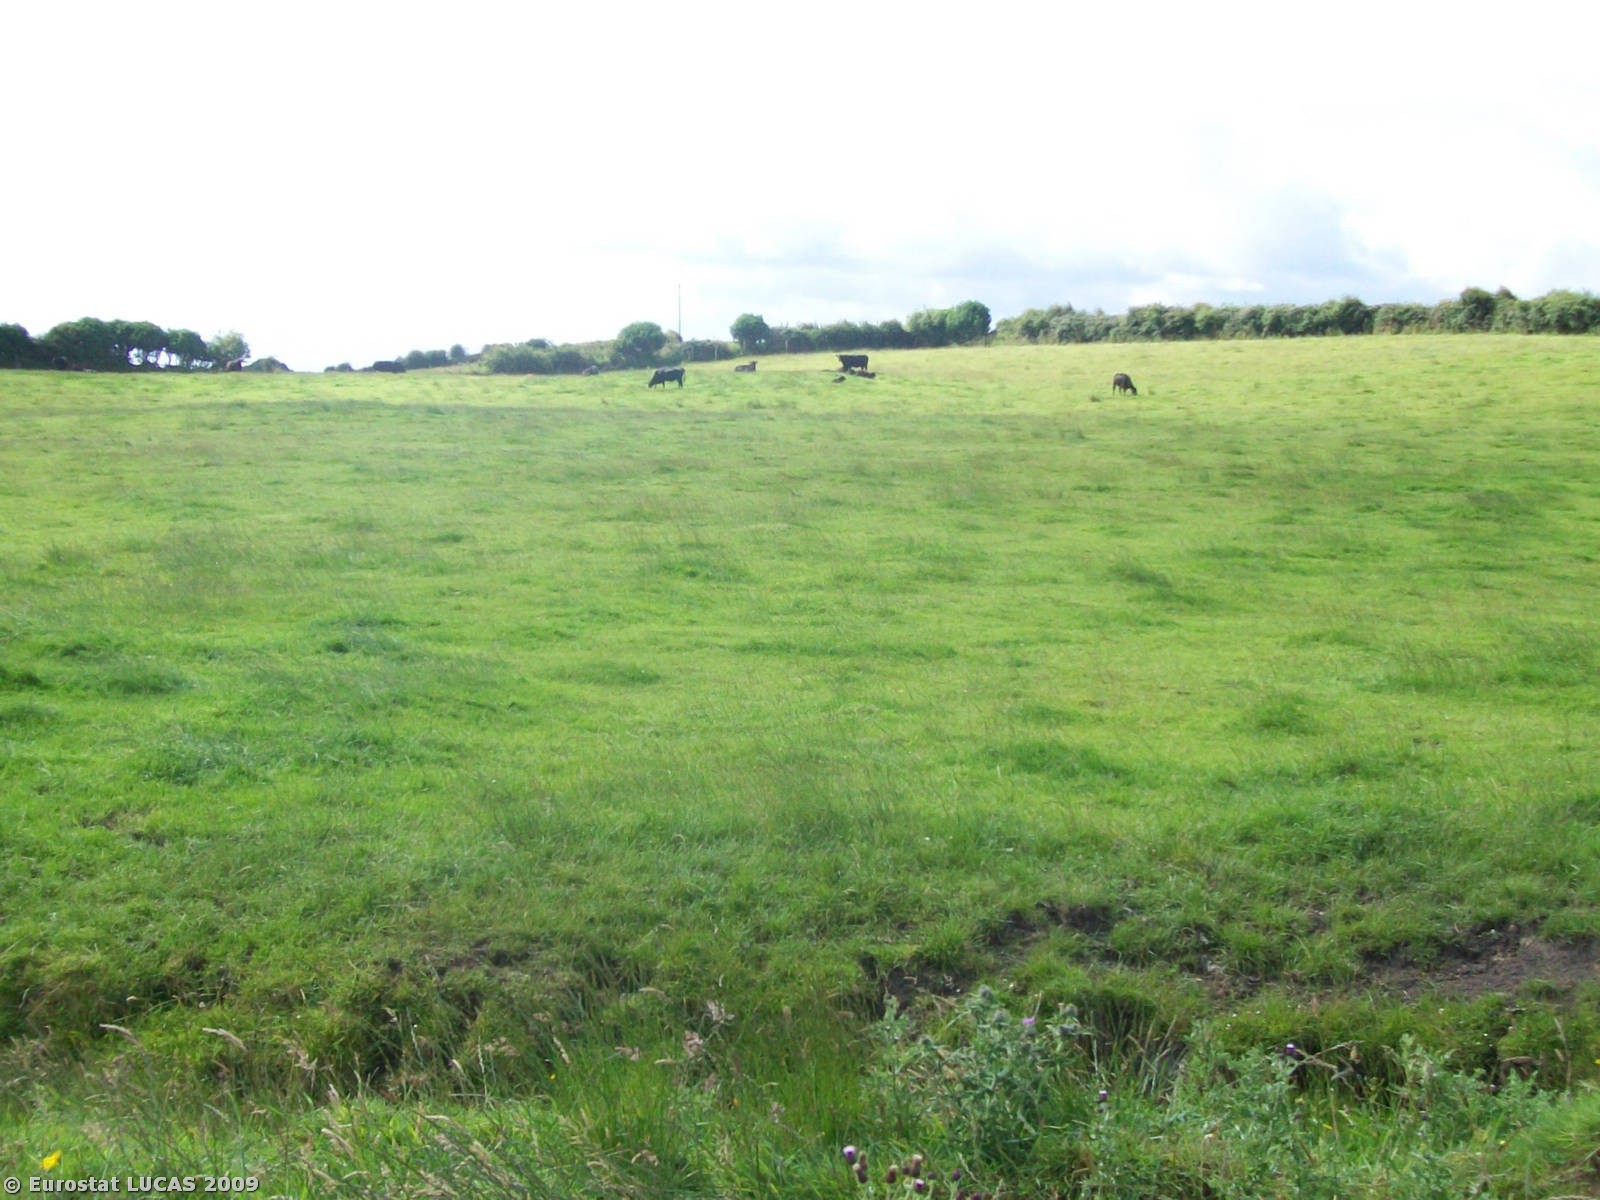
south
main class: Grassland
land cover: Grassland without tree/shrub cover
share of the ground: > 75 %
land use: Agriculture (excluding fallow land and kitchen gardens)
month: July
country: IE
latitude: 54.2072
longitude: -9.2479
